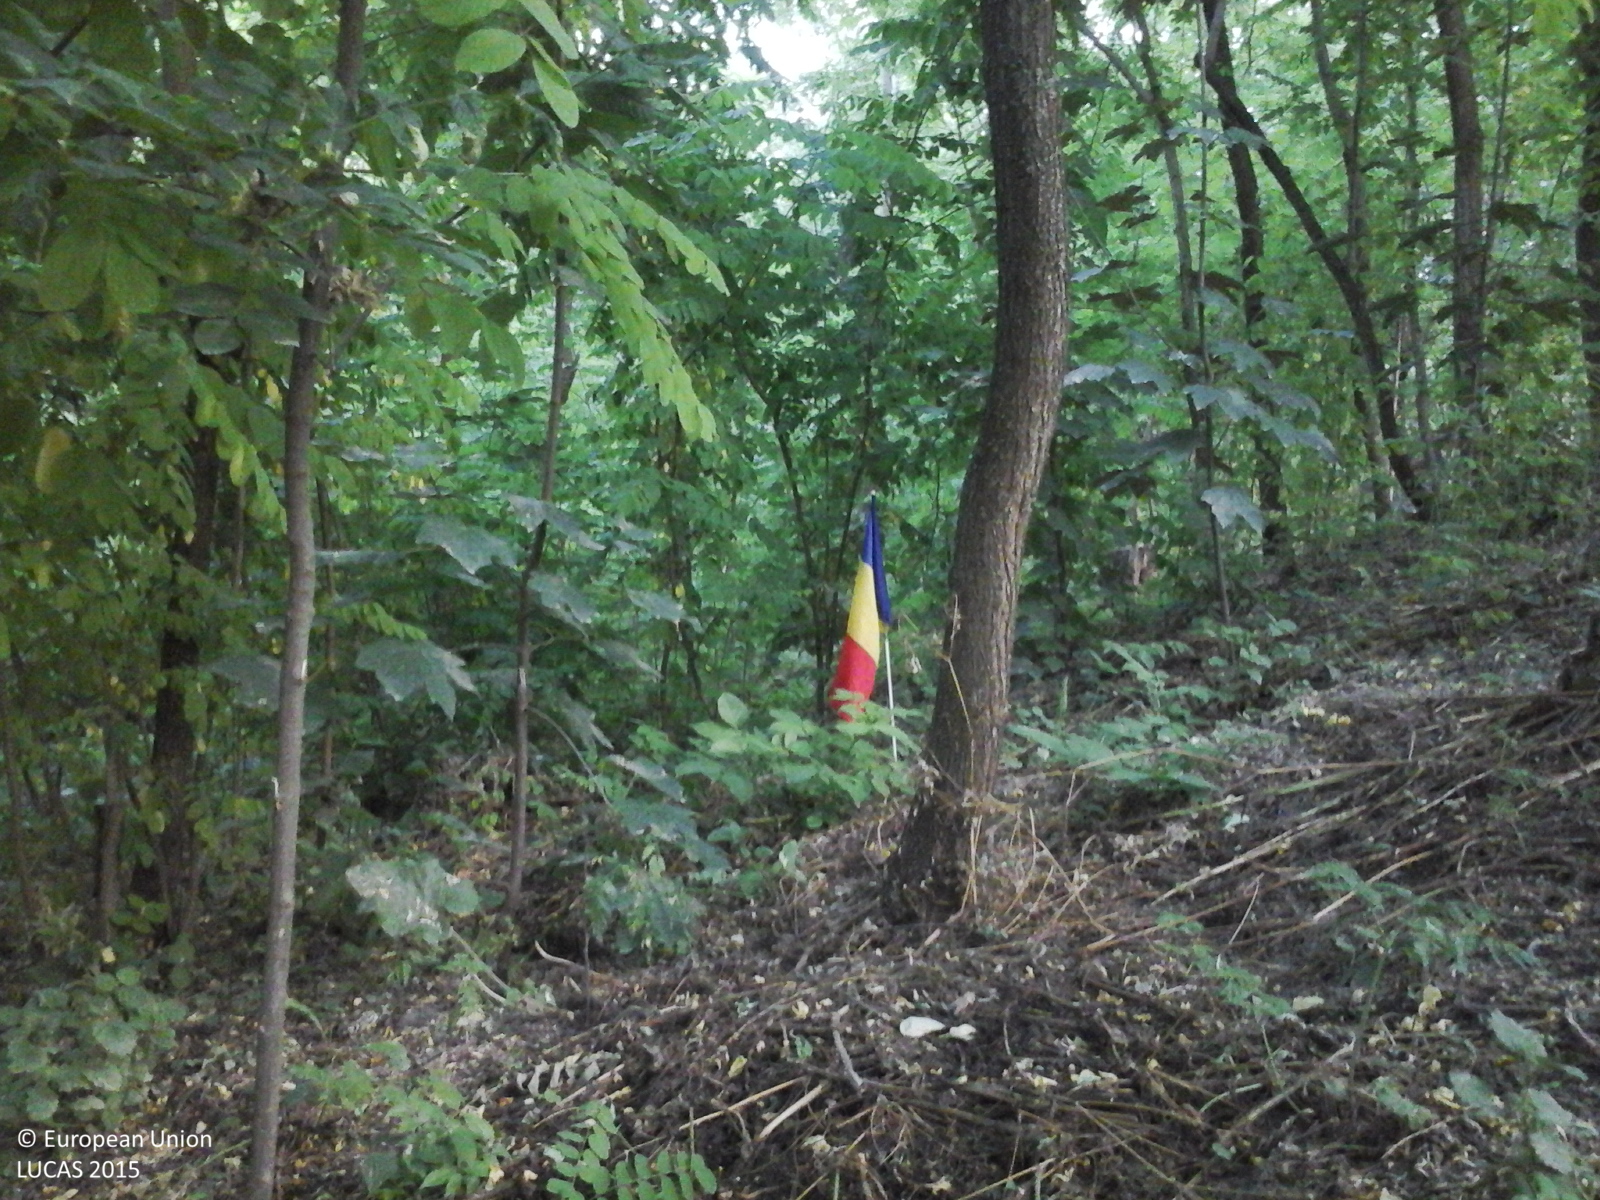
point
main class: Woodland
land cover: Broadleaved woodland
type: floodplain forest
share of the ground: > 75 %
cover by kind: broadleaved forest trees 100 %
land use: Semi-natural and natural areas not in use
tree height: > 5 m
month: June
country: RO
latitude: 47.5172
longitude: 26.5162
